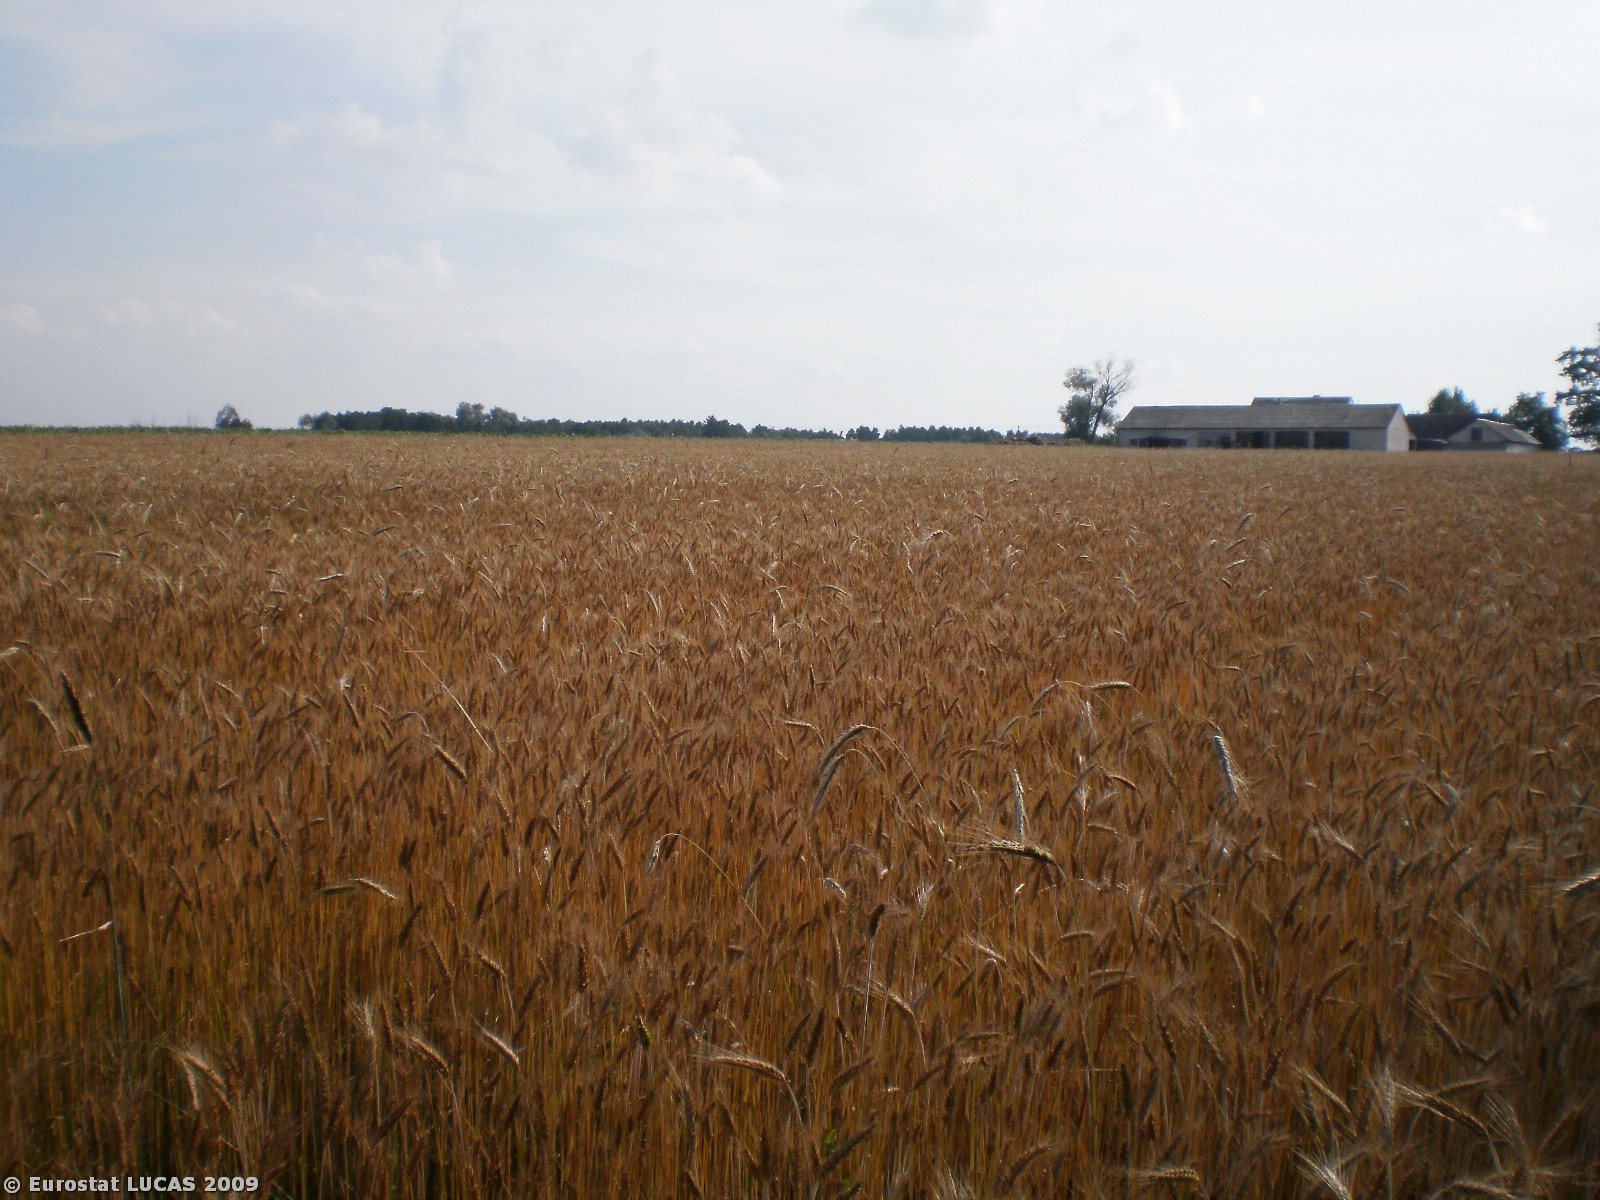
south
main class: Cropland
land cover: Triticale
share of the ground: > 75 %
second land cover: Rye
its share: < 10 %
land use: Agriculture (excluding fallow land and kitchen gardens)
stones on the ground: < 10 %
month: July
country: PL
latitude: 52.7148
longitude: 20.8334
